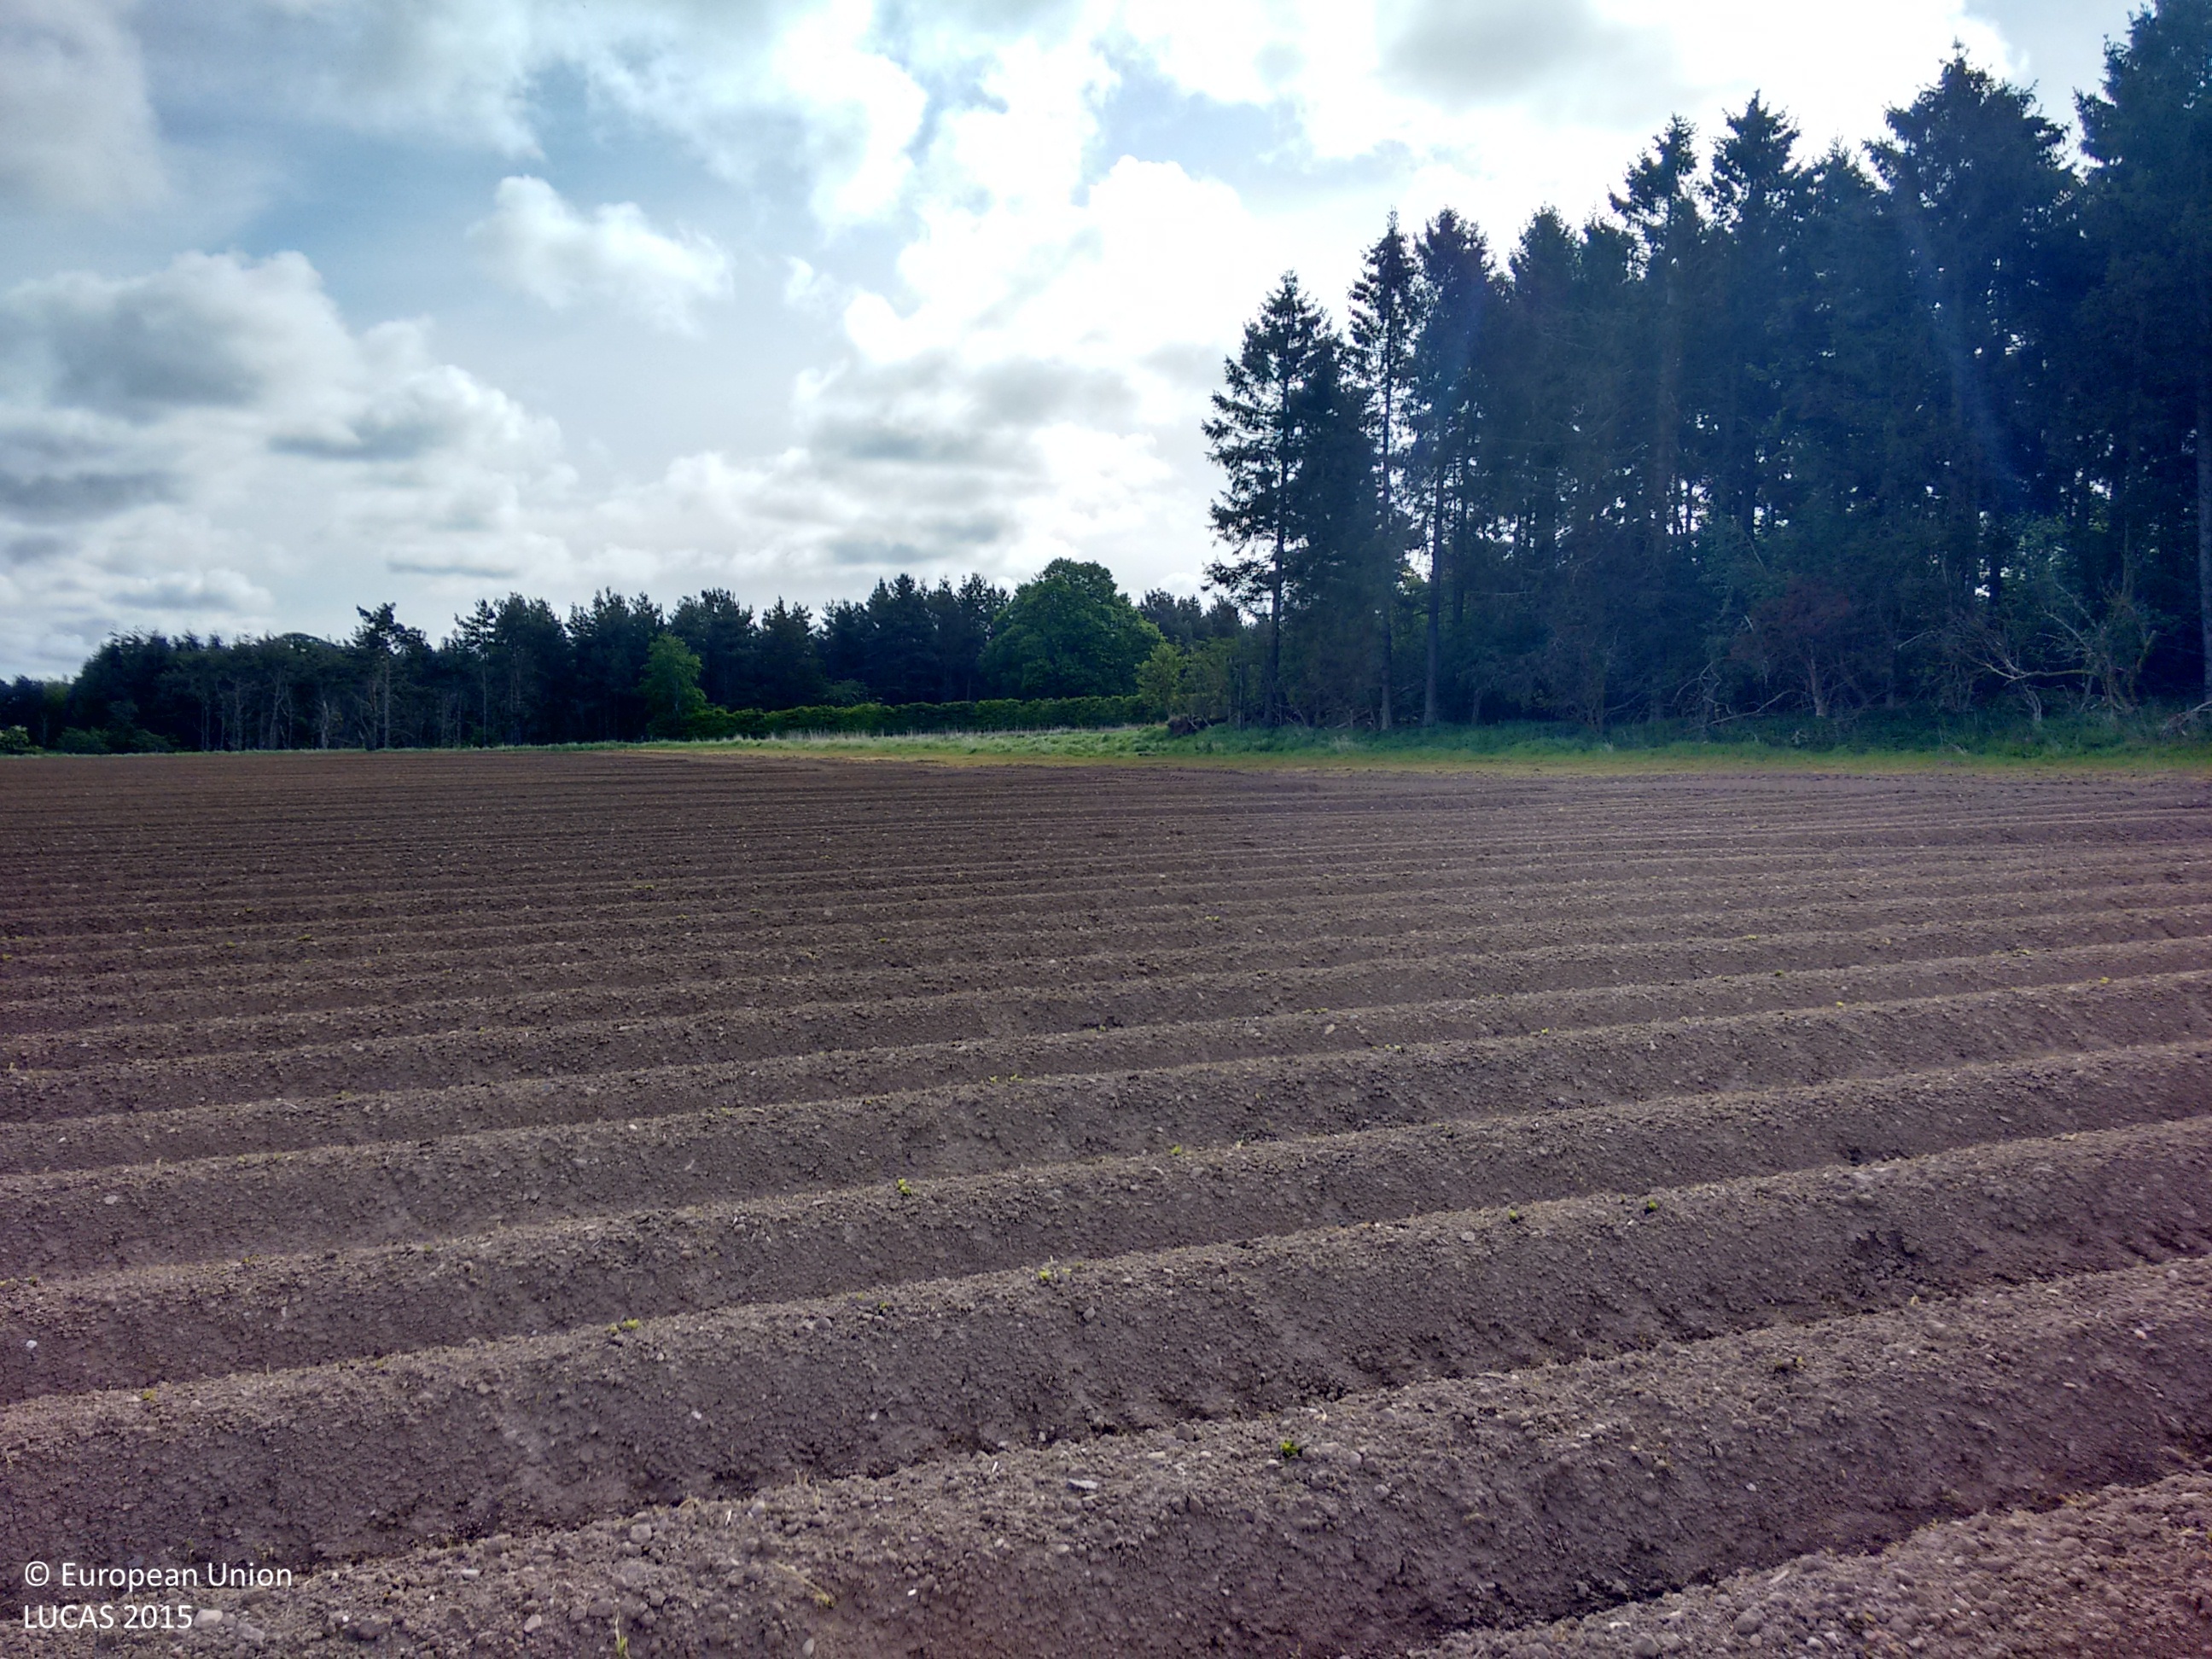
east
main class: Cropland
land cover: Potatoes
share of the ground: < 10 %
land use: Agriculture (excluding fallow land and kitchen gardens)
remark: Tilled/Sowed
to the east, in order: Potatoes; Grassland without tree/shrub cover; Fences; Spruce dominated mixed woodland; Grassland without tree/shrub cover; Fences; Grass margins; Tracks; Grass margins; Fences; Managed hedges; Fences; Grassland with sparse tree/shrub cover; Grassland without tree/shrub cover; Tracks; Grassland without tree/shrub cover; Fences; Pine dominated mixed woodland; Grassland without tree/shrub cover
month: May
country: GB
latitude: 55.9450
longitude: -2.7939
